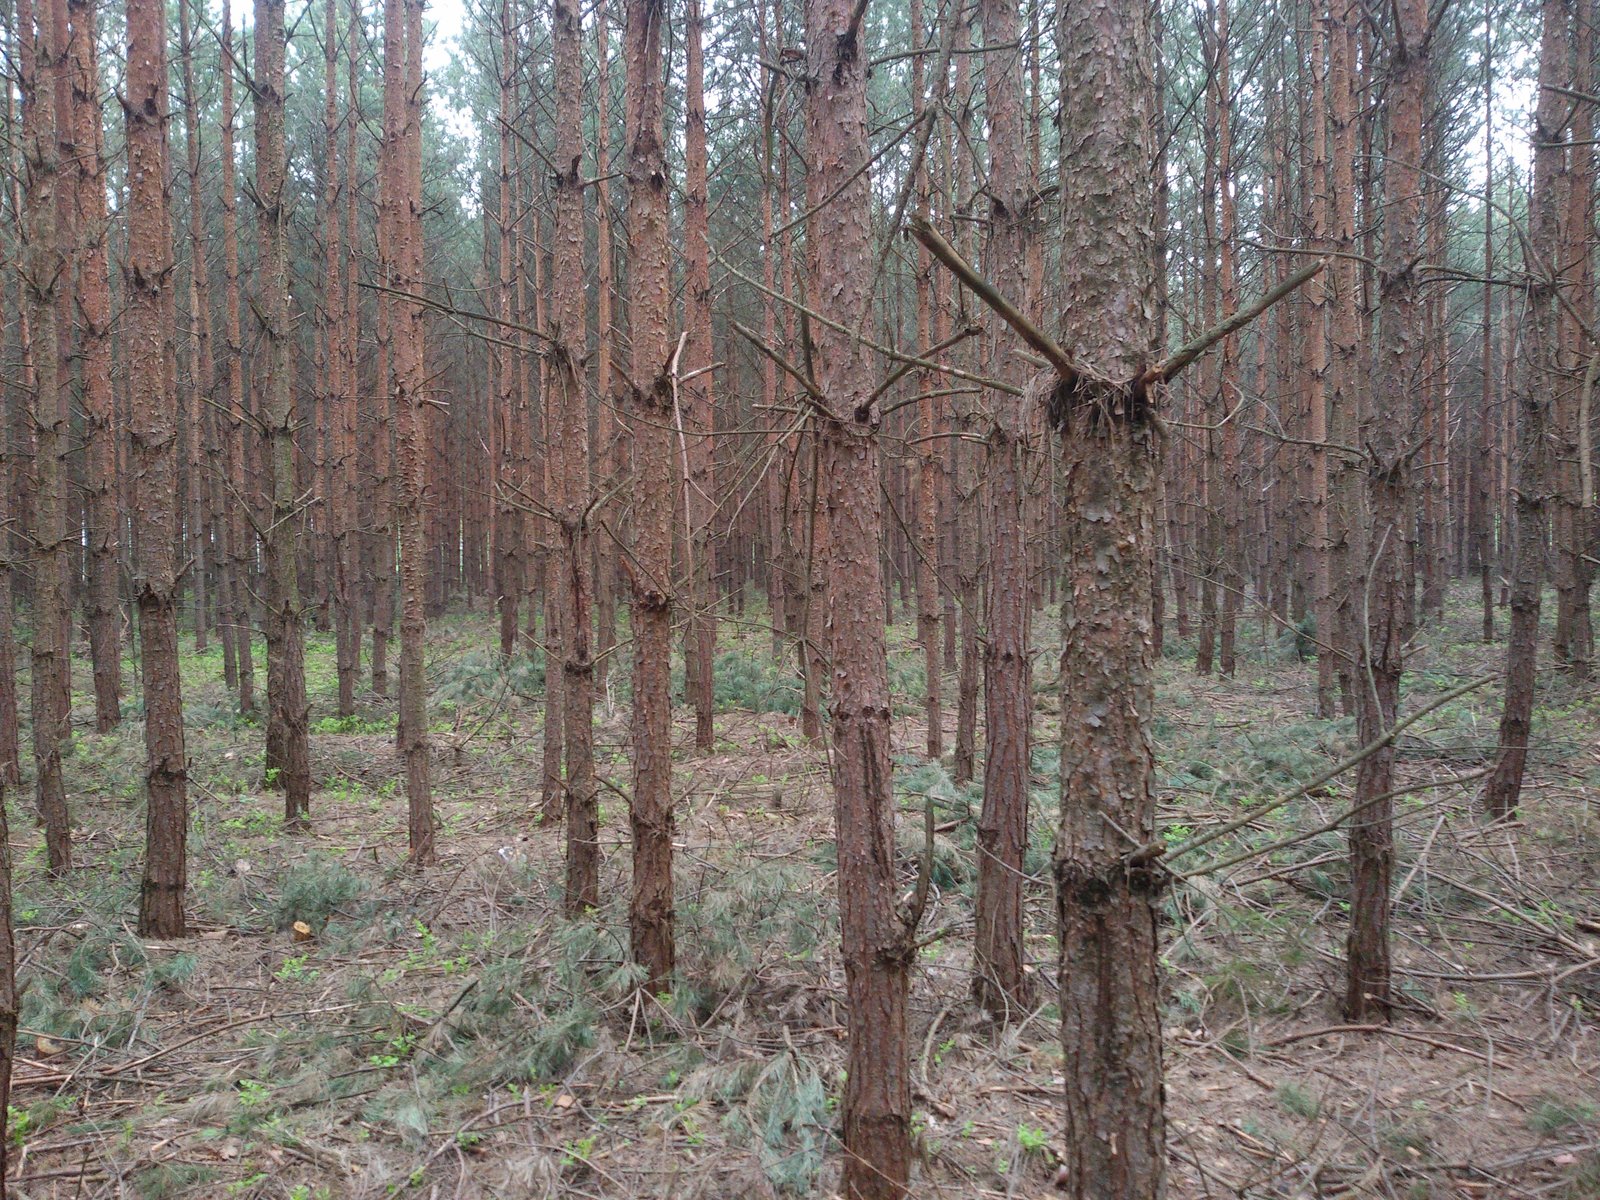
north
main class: Woodland
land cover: Pine dominated coniferous woodland
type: hemiboreal forest and nemoral coniferous forest and mixed broadleaved-coniferous forest
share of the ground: > 75 %
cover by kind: coniferous forest trees 80 %, herbaceous plants 10 %, broadleaved forest trees 5 %, shrubs 5 %
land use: Forestry
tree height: > 5 m
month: May
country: PL
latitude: 50.4397
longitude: 21.6407
